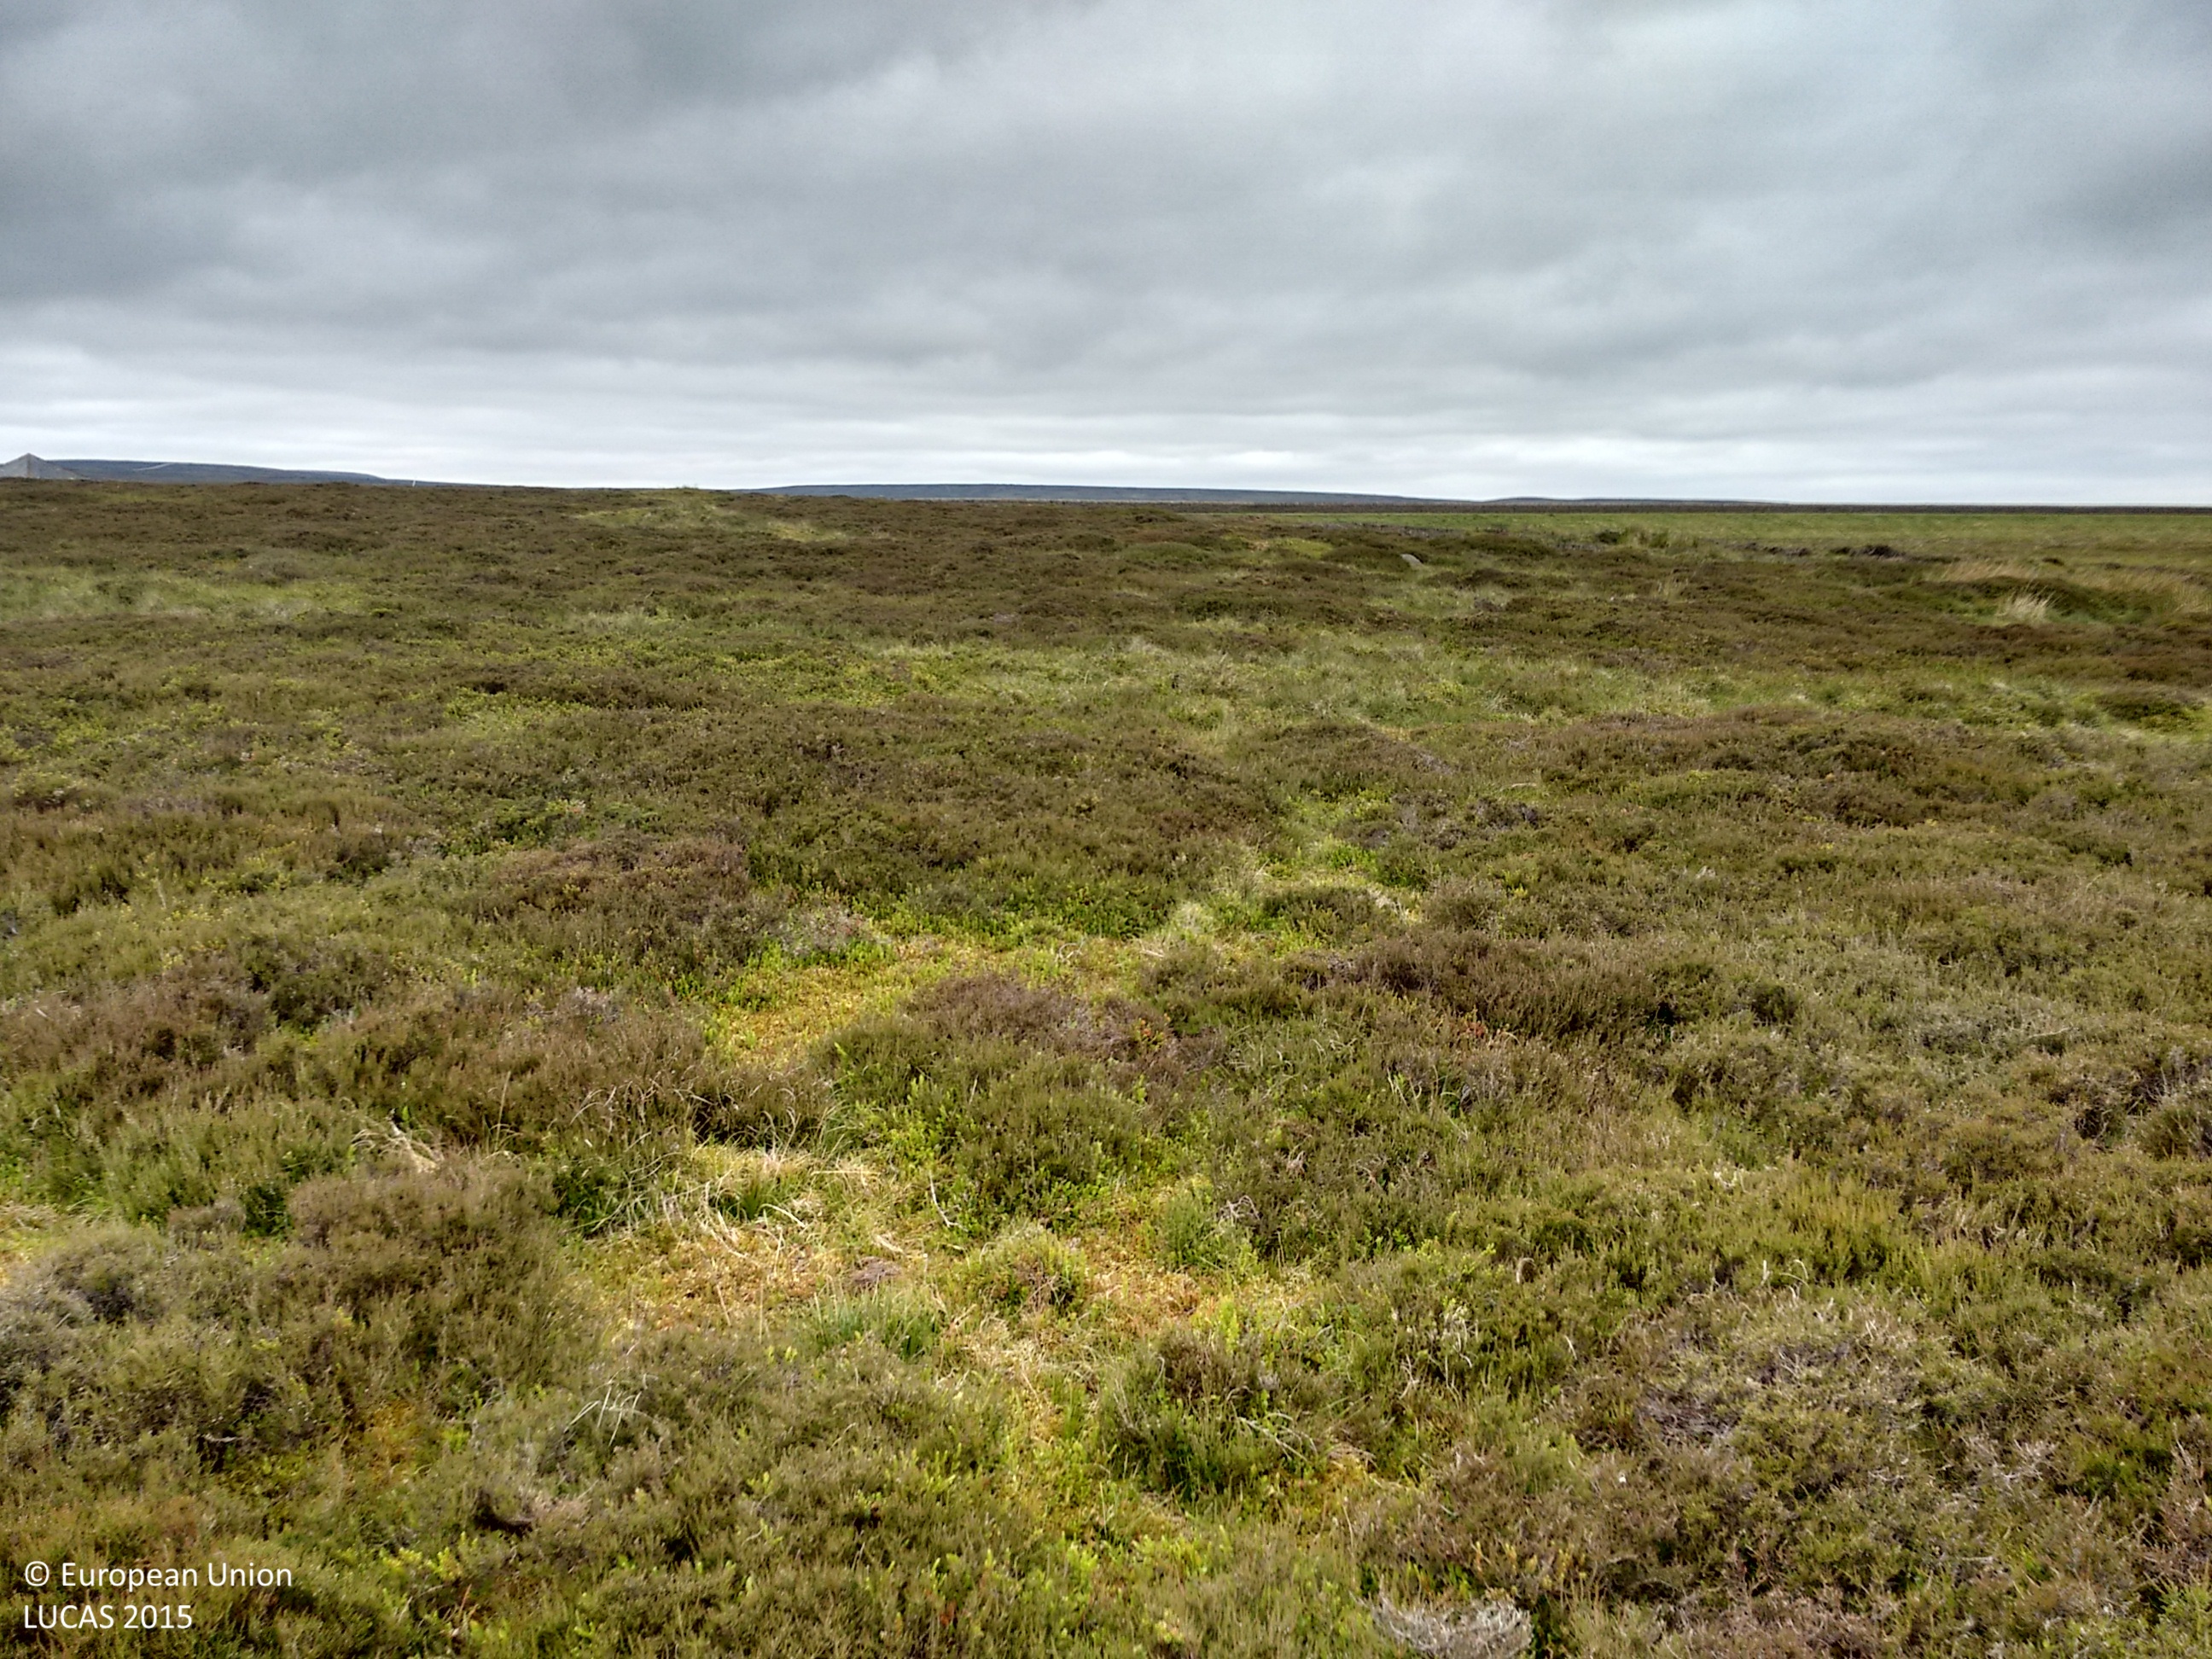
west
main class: Shrubland
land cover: Shrubland without tree cover
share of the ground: > 75 %
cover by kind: shrubs 90 %, herbaceous plants 10 %
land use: Agriculture (excluding fallow land and kitchen gardens)
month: June
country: GB
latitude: 54.8105
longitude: -1.9260
